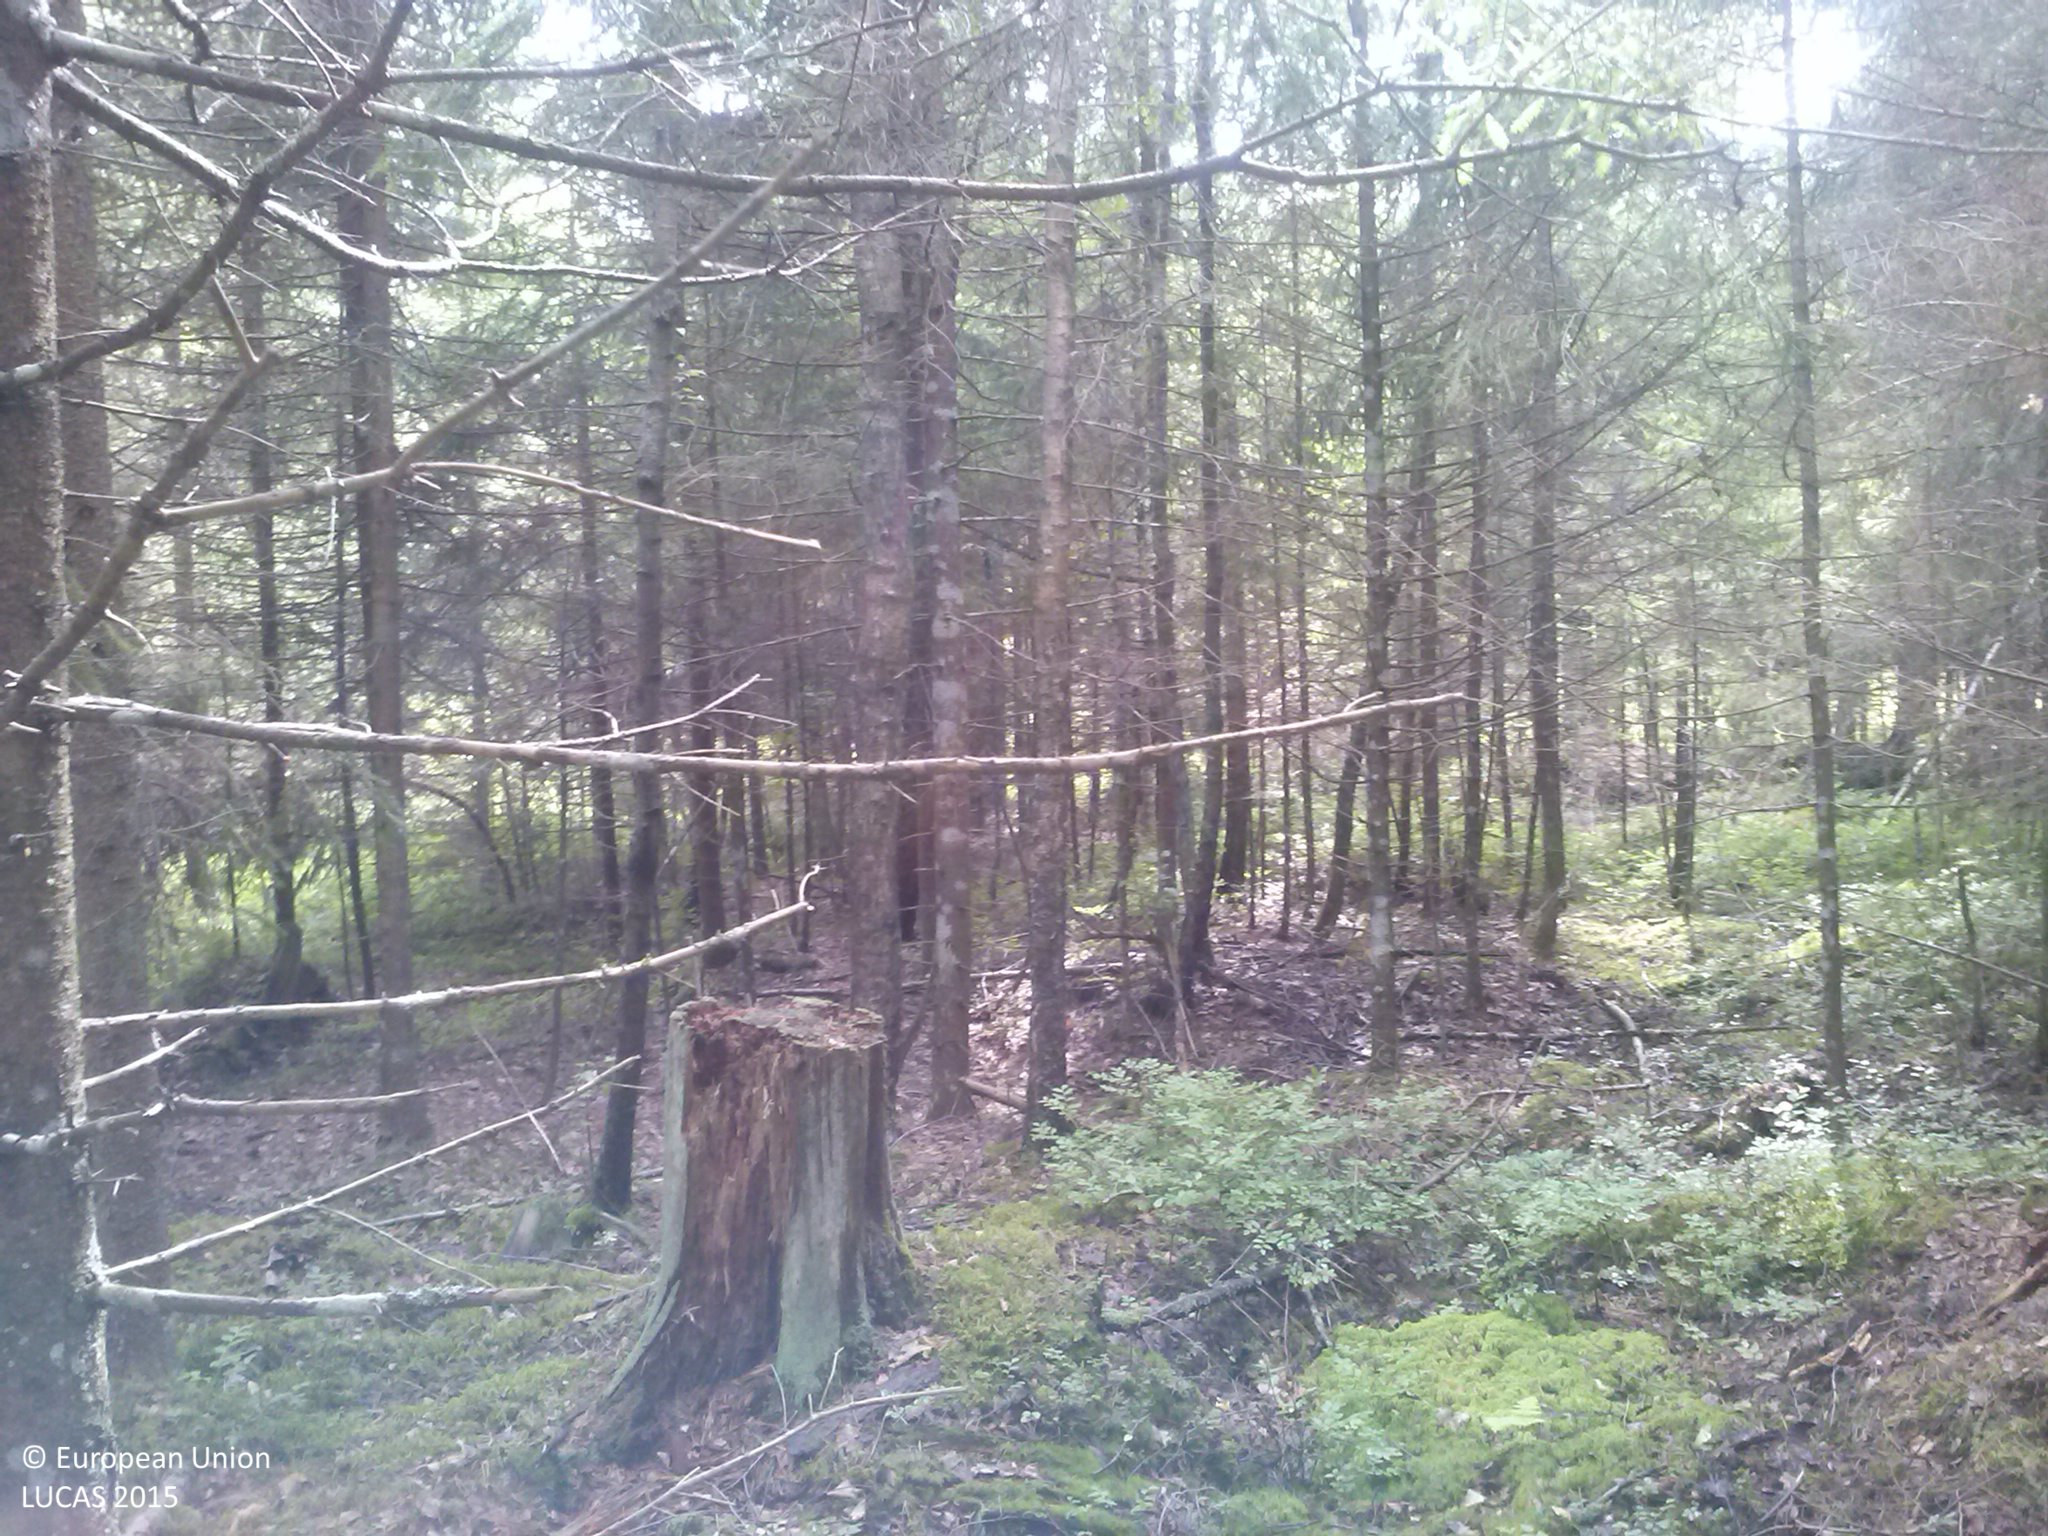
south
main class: Woodland
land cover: Spruce dominated coniferous woodland
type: hemiboreal forest and nemoral coniferous forest and mixed broadleaved-coniferous forest
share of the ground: > 75 %
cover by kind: coniferous forest trees 75 %, herbaceous plants 15 %, lichens and mosses 10 %
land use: Forestry
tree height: > 5 m
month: July
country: LV
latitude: 56.8131
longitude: 27.5256
